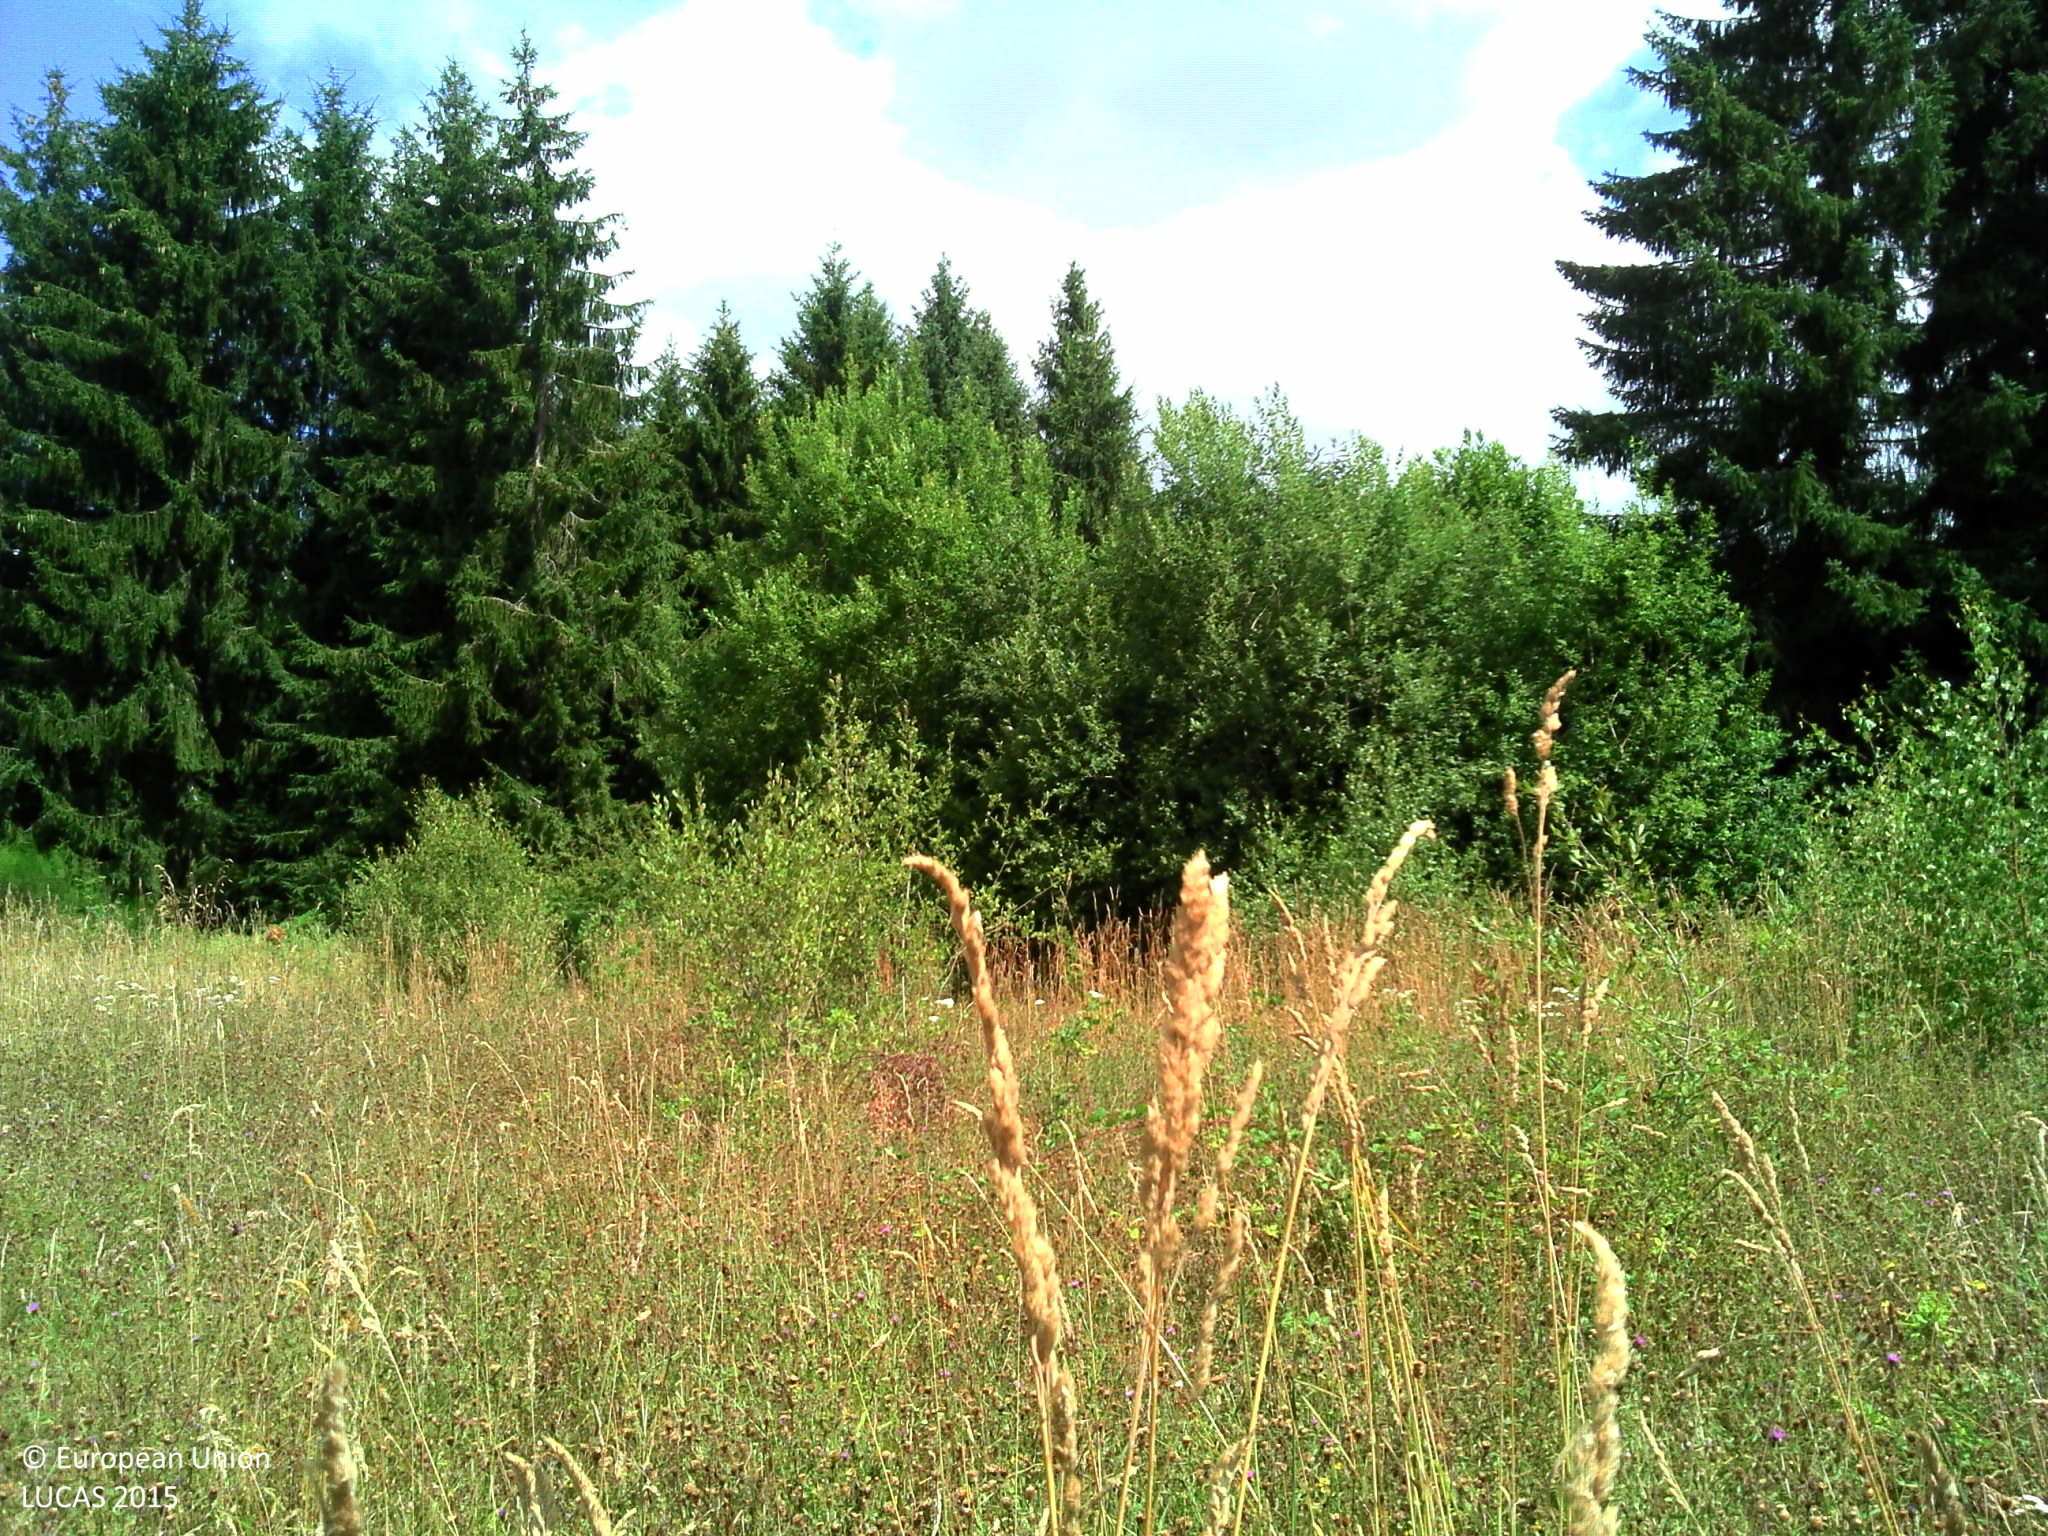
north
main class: Grassland
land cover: Spontaneously vegetated surfaces
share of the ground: > 75 %
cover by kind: herbaceous plants 95 %
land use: Agriculture (excluding fallow land and kitchen gardens)
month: July
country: FR
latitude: 45.6154
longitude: 1.0780
